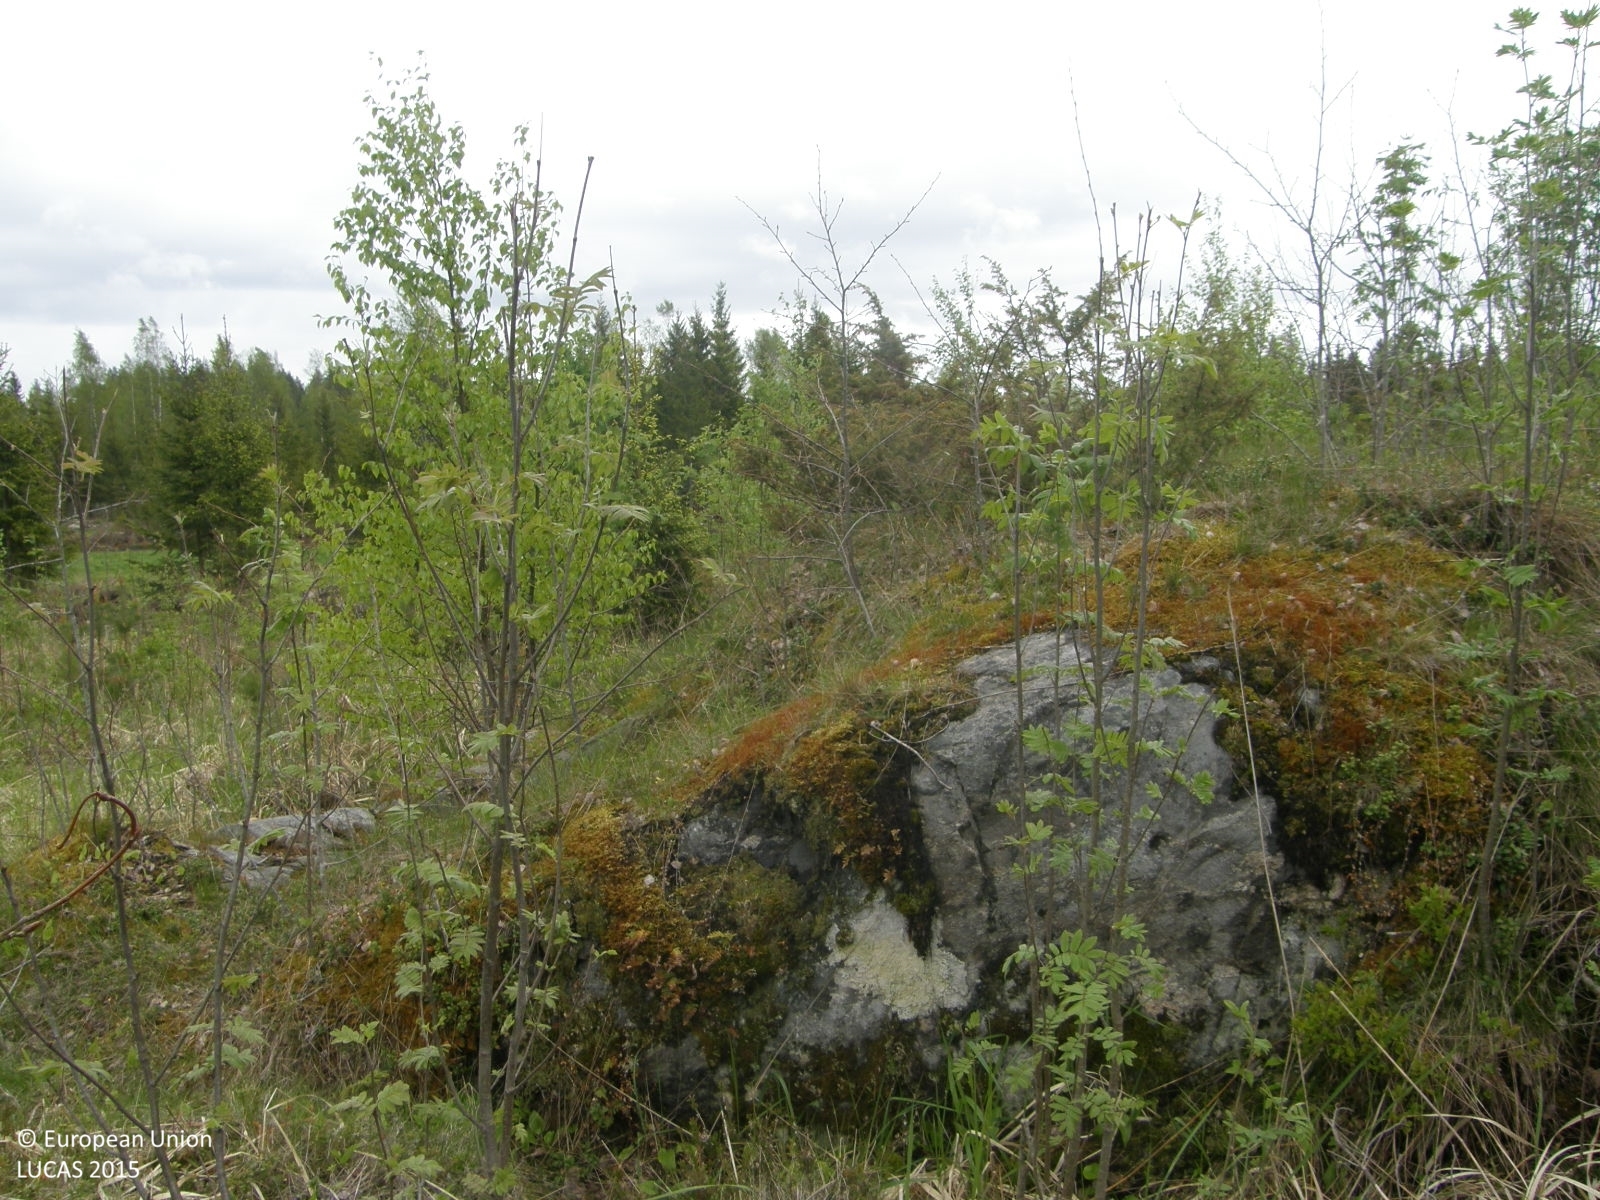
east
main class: Woodland
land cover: Other mixed woodland
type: boreal forest
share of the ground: 50 - 75 %
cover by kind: broadleaved forest trees 40 %, coniferous forest trees 25 %, herbaceous plants 20 %, shrubs 10 %, lichens and mosses 5 %
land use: Forestry
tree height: < 5 m
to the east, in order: Other mixed woodland; Ditches and canals; Tracks; Temporary grasslands; Ditches and canals; Spruce dominated coniferous woodland; Spruce dominated mixed woodland; Ditches and canals; Tracks; Spruce dominated coniferous woodland; Ditches and canals; Spruce dominated coniferous woodland
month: June
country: FI
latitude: 62.0189
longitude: 21.5683
